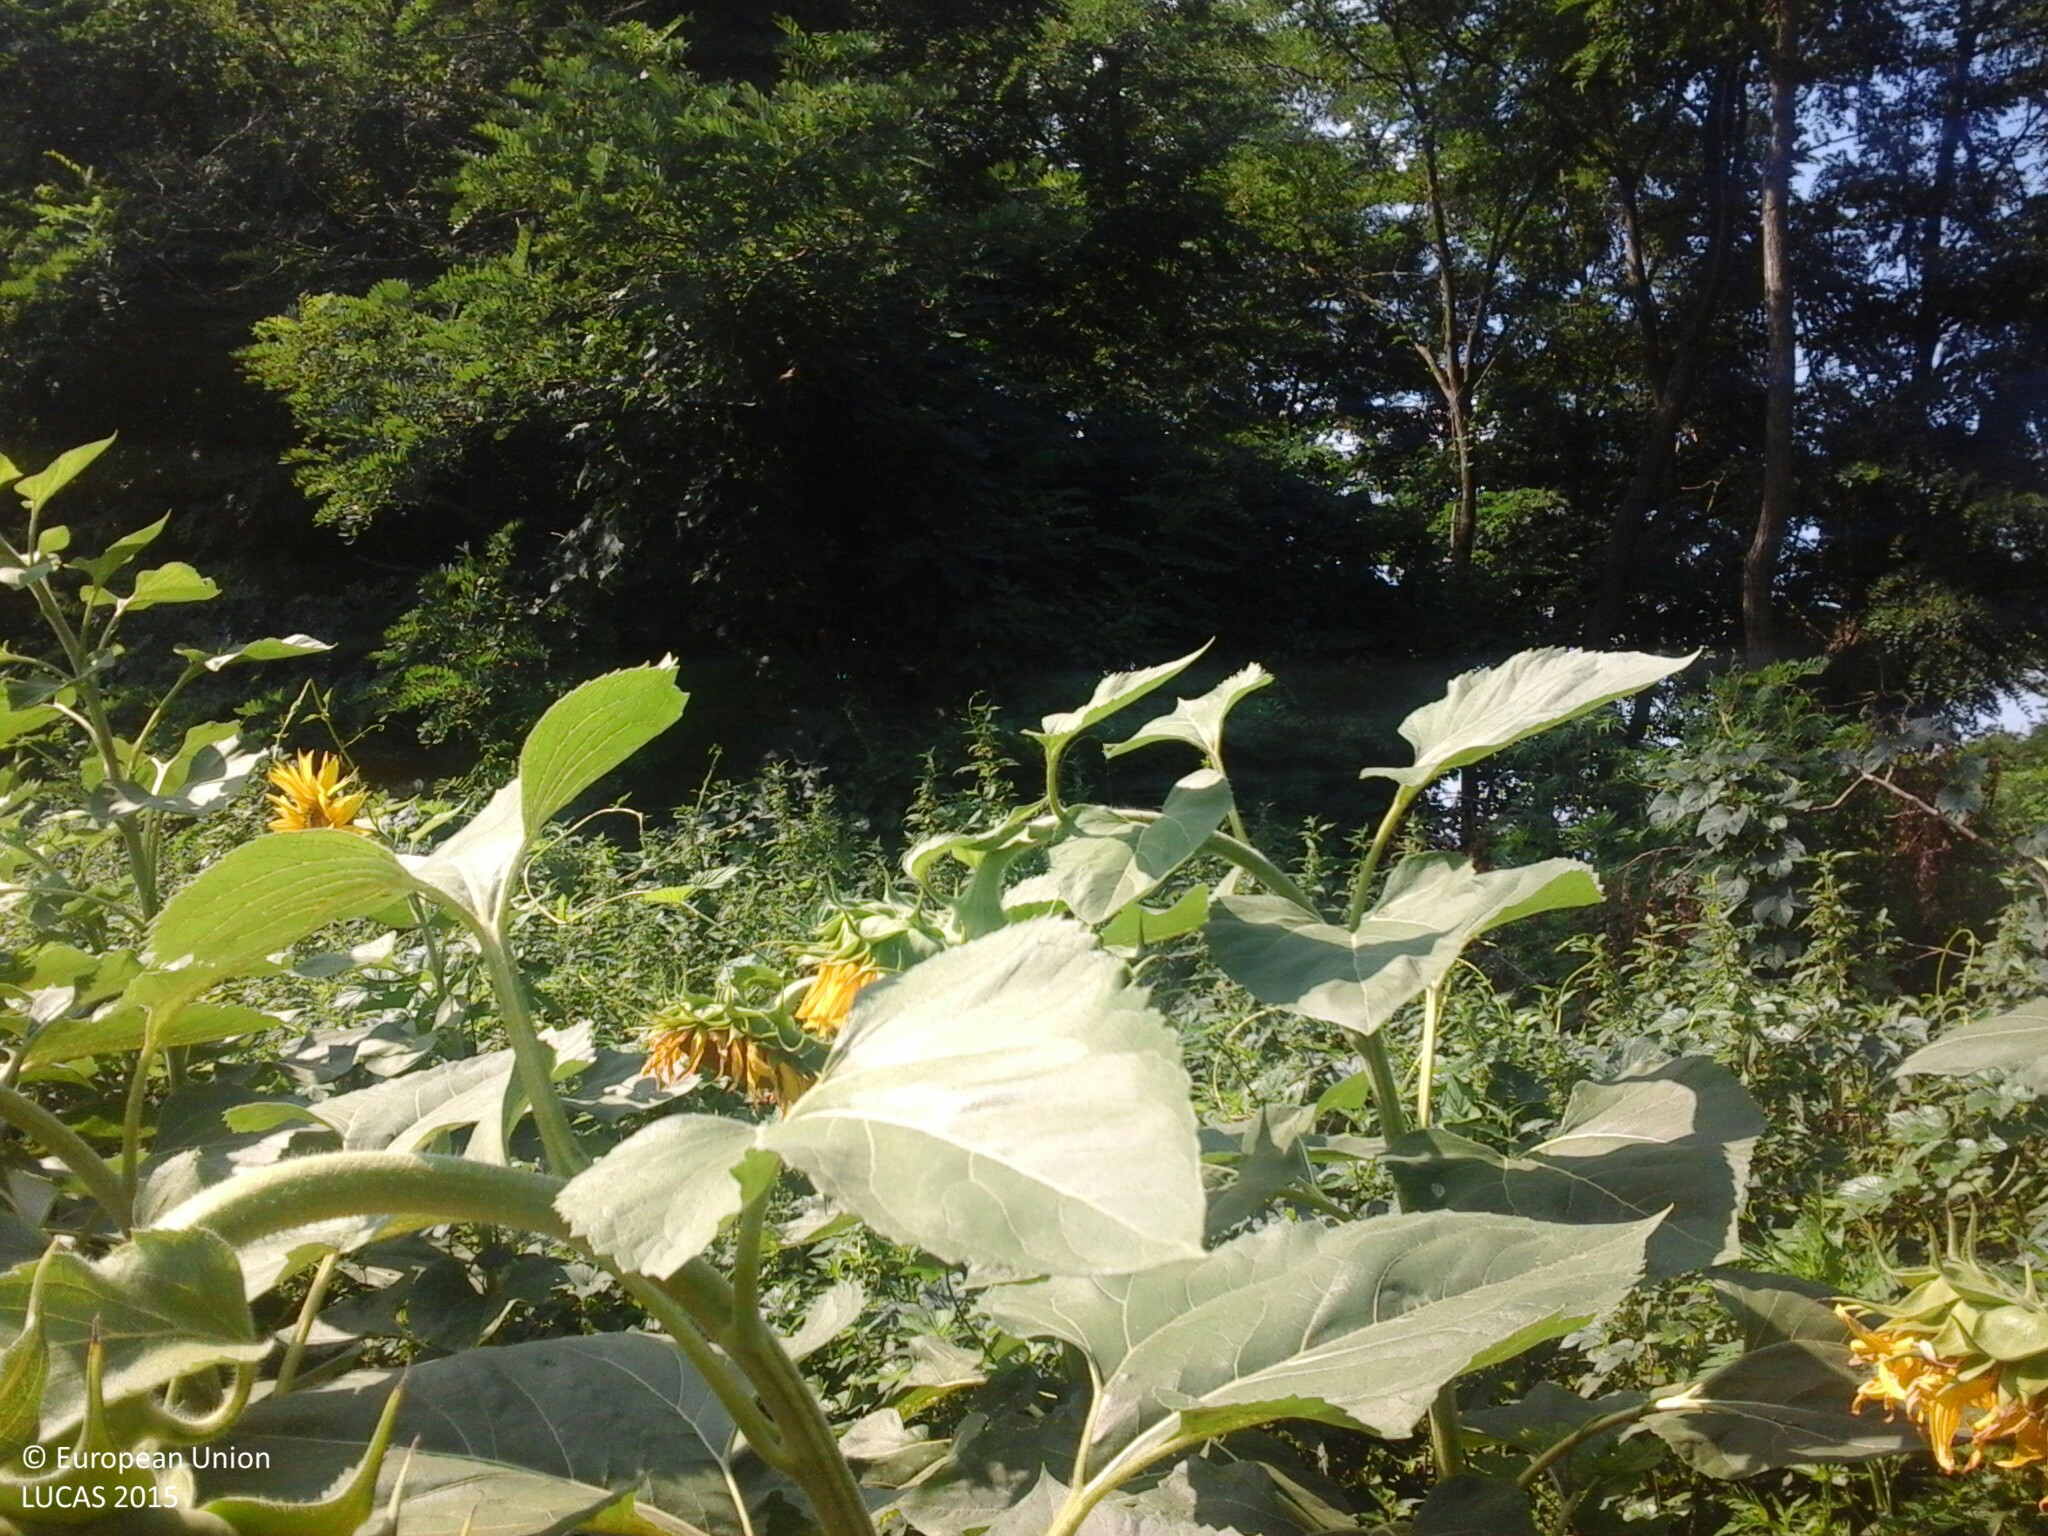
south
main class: Cropland
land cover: Sunflower
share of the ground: > 75 %
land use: Agriculture (excluding fallow land and kitchen gardens)
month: August
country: HU
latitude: 47.4914
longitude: 18.3350
